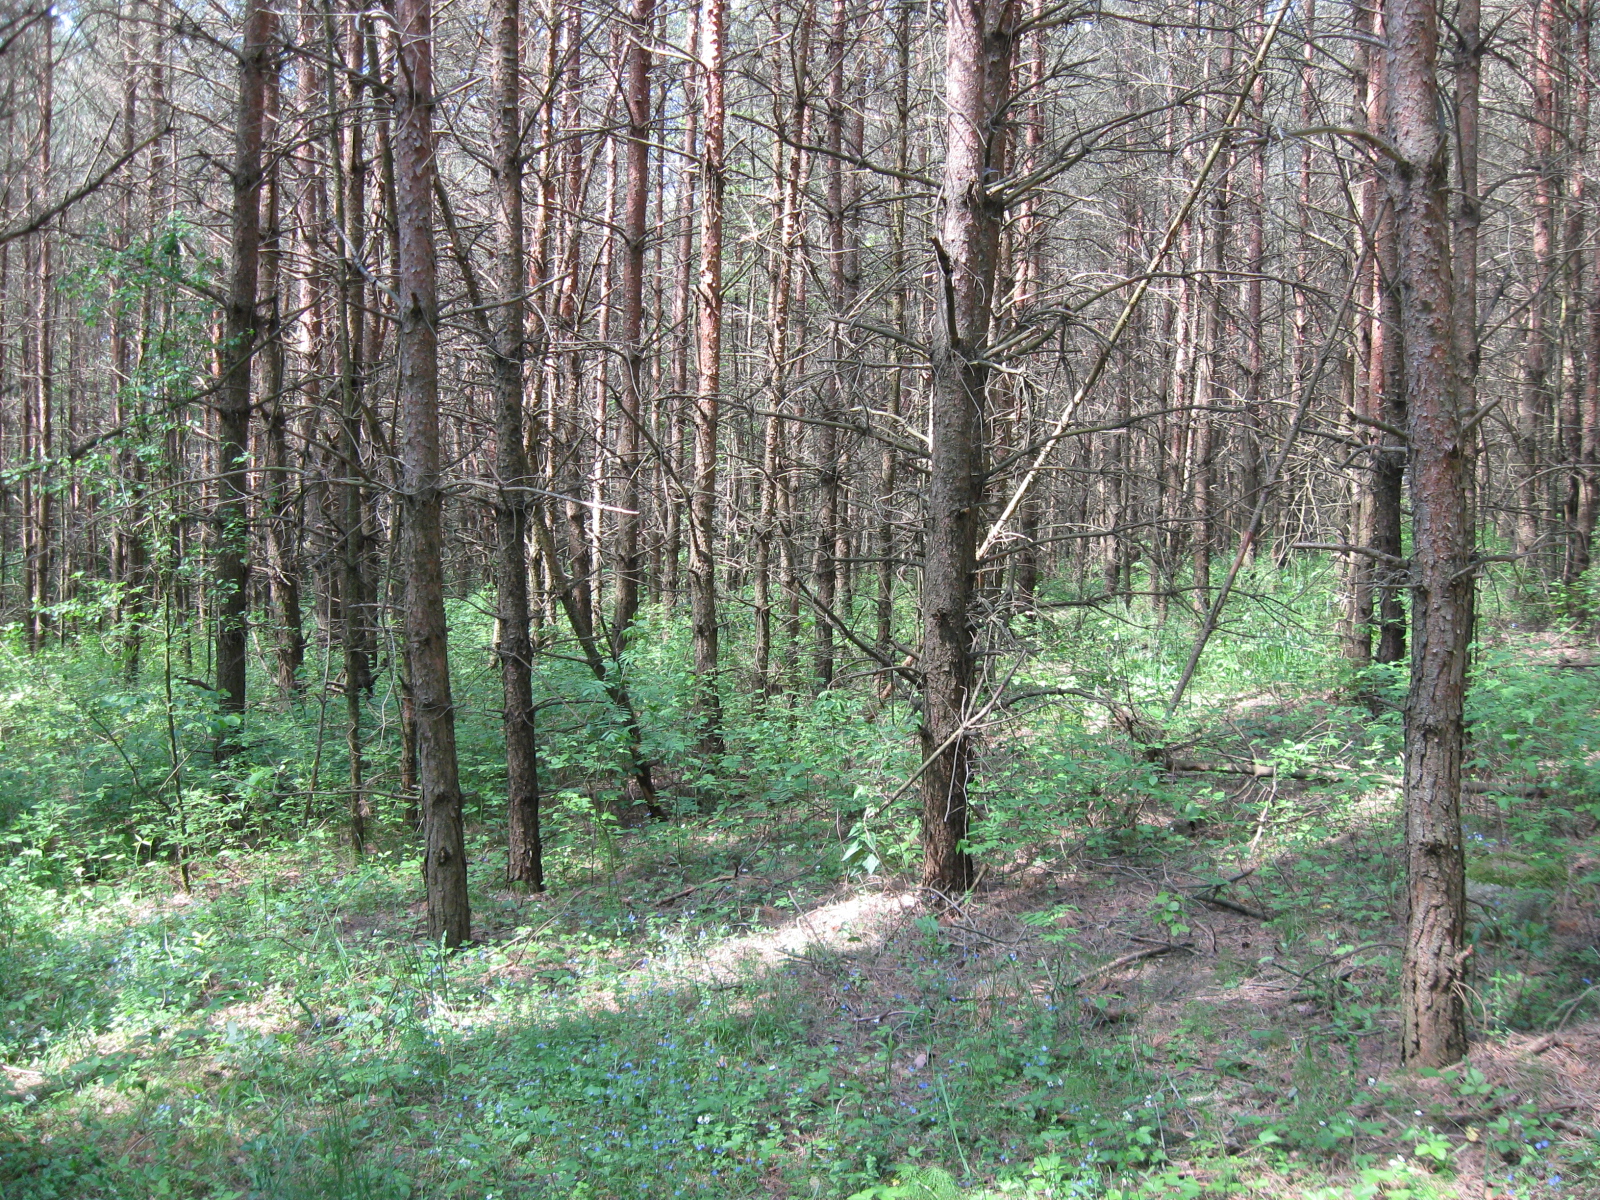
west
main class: Woodland
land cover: Pine dominated coniferous woodland
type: hemiboreal forest and nemoral coniferous forest and mixed broadleaved-coniferous forest
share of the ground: > 75 %
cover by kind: coniferous forest trees 85 %, broadleaved forest trees 10 %, herbaceous plants 5 %
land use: Forestry
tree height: > 5 m
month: June
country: LT
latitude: 54.2012
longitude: 23.7462
